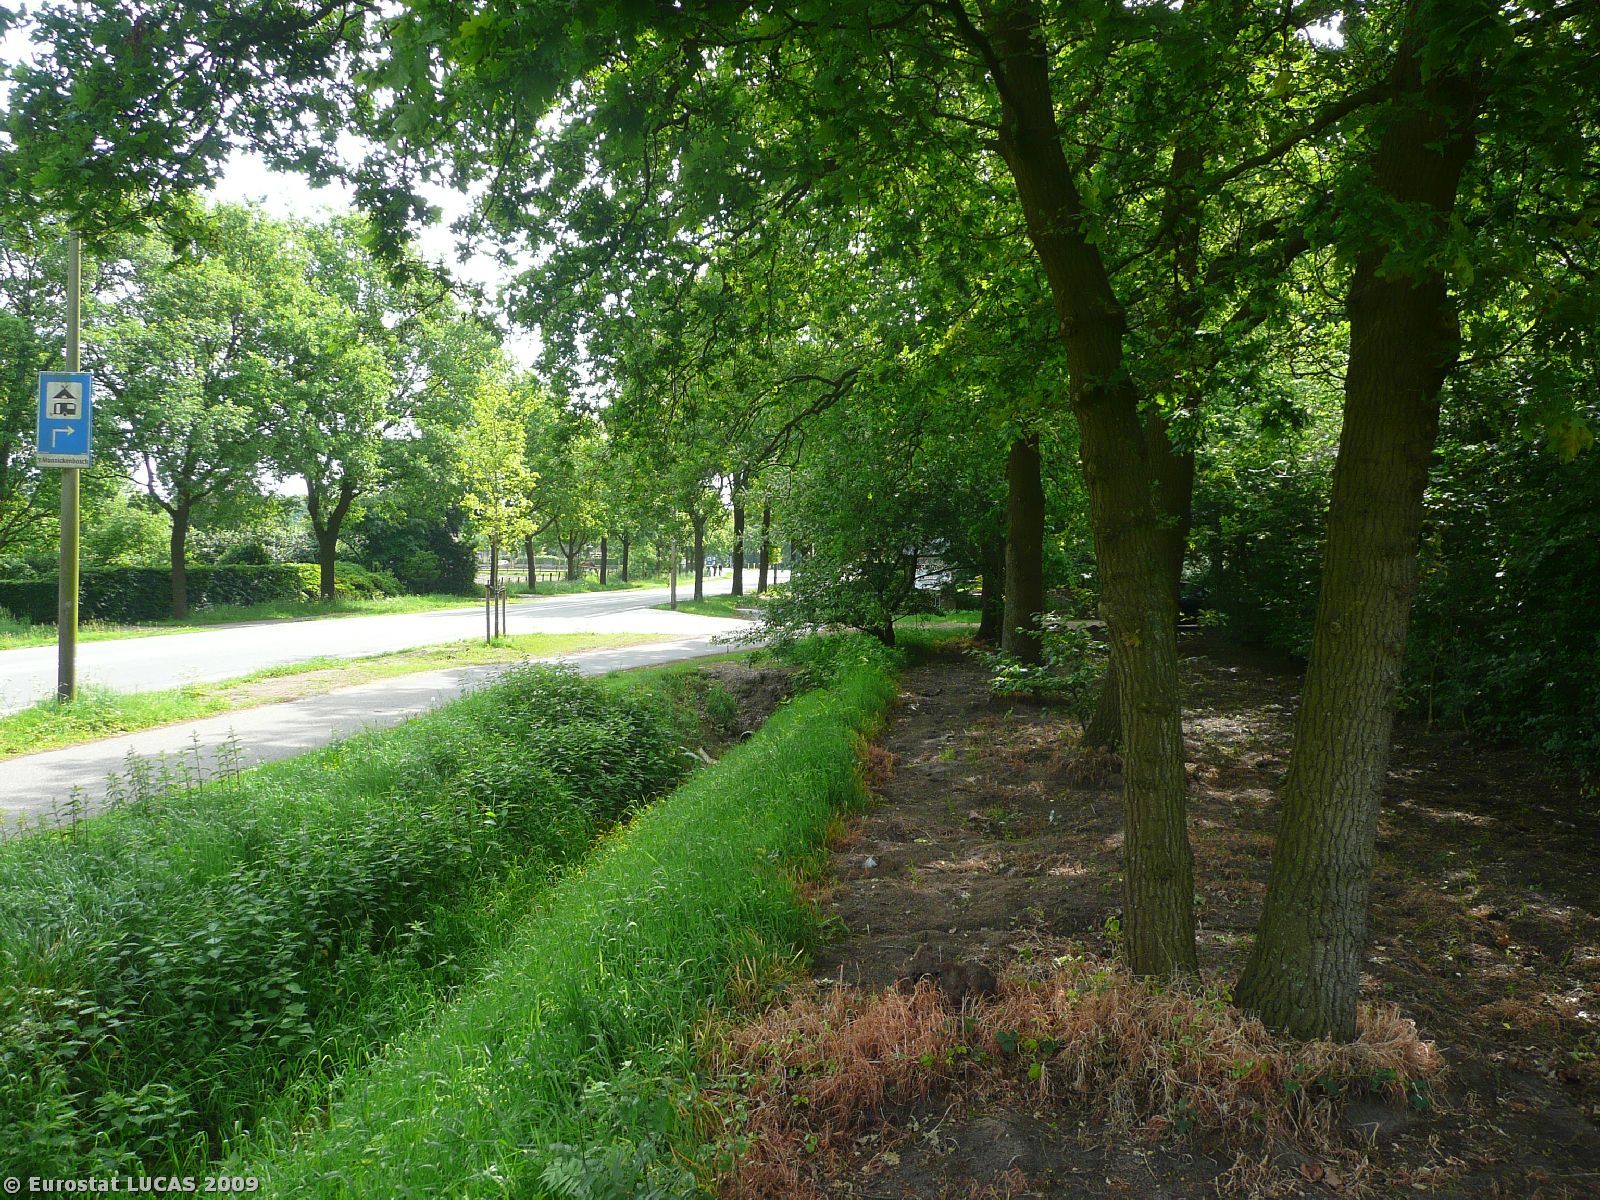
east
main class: Woodland
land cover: Coniferous woodland
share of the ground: > 75 %
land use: Residential
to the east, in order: Coniferous woodland; Fences; Managed hedges; Grassland without tree/shrub cover; Fences; Artificial constructions in urban areas
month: May
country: NL
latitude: 52.1598
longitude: 5.3349
